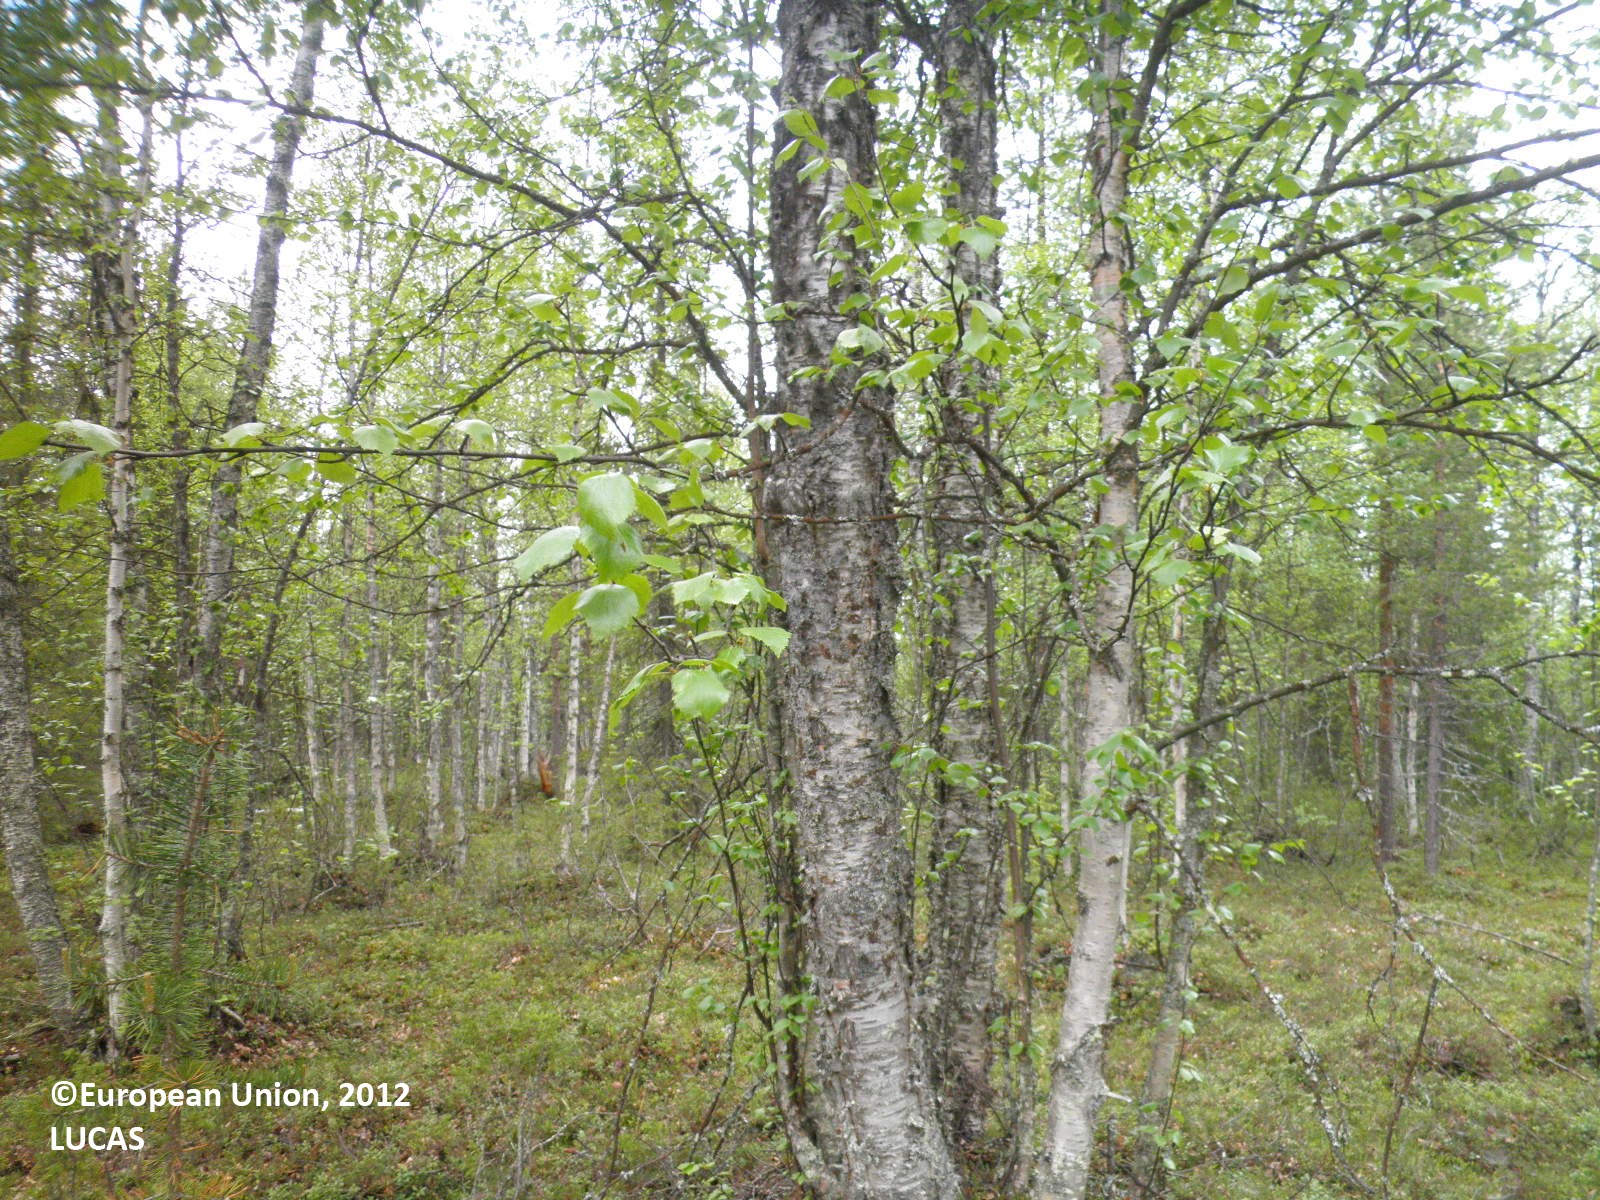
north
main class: Woodland
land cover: Pine dominated mixed woodland
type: boreal forest
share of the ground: 25 - 50 %
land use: Forestry
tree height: > 5 m
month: June
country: FI
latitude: 67.9312
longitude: 25.4728
